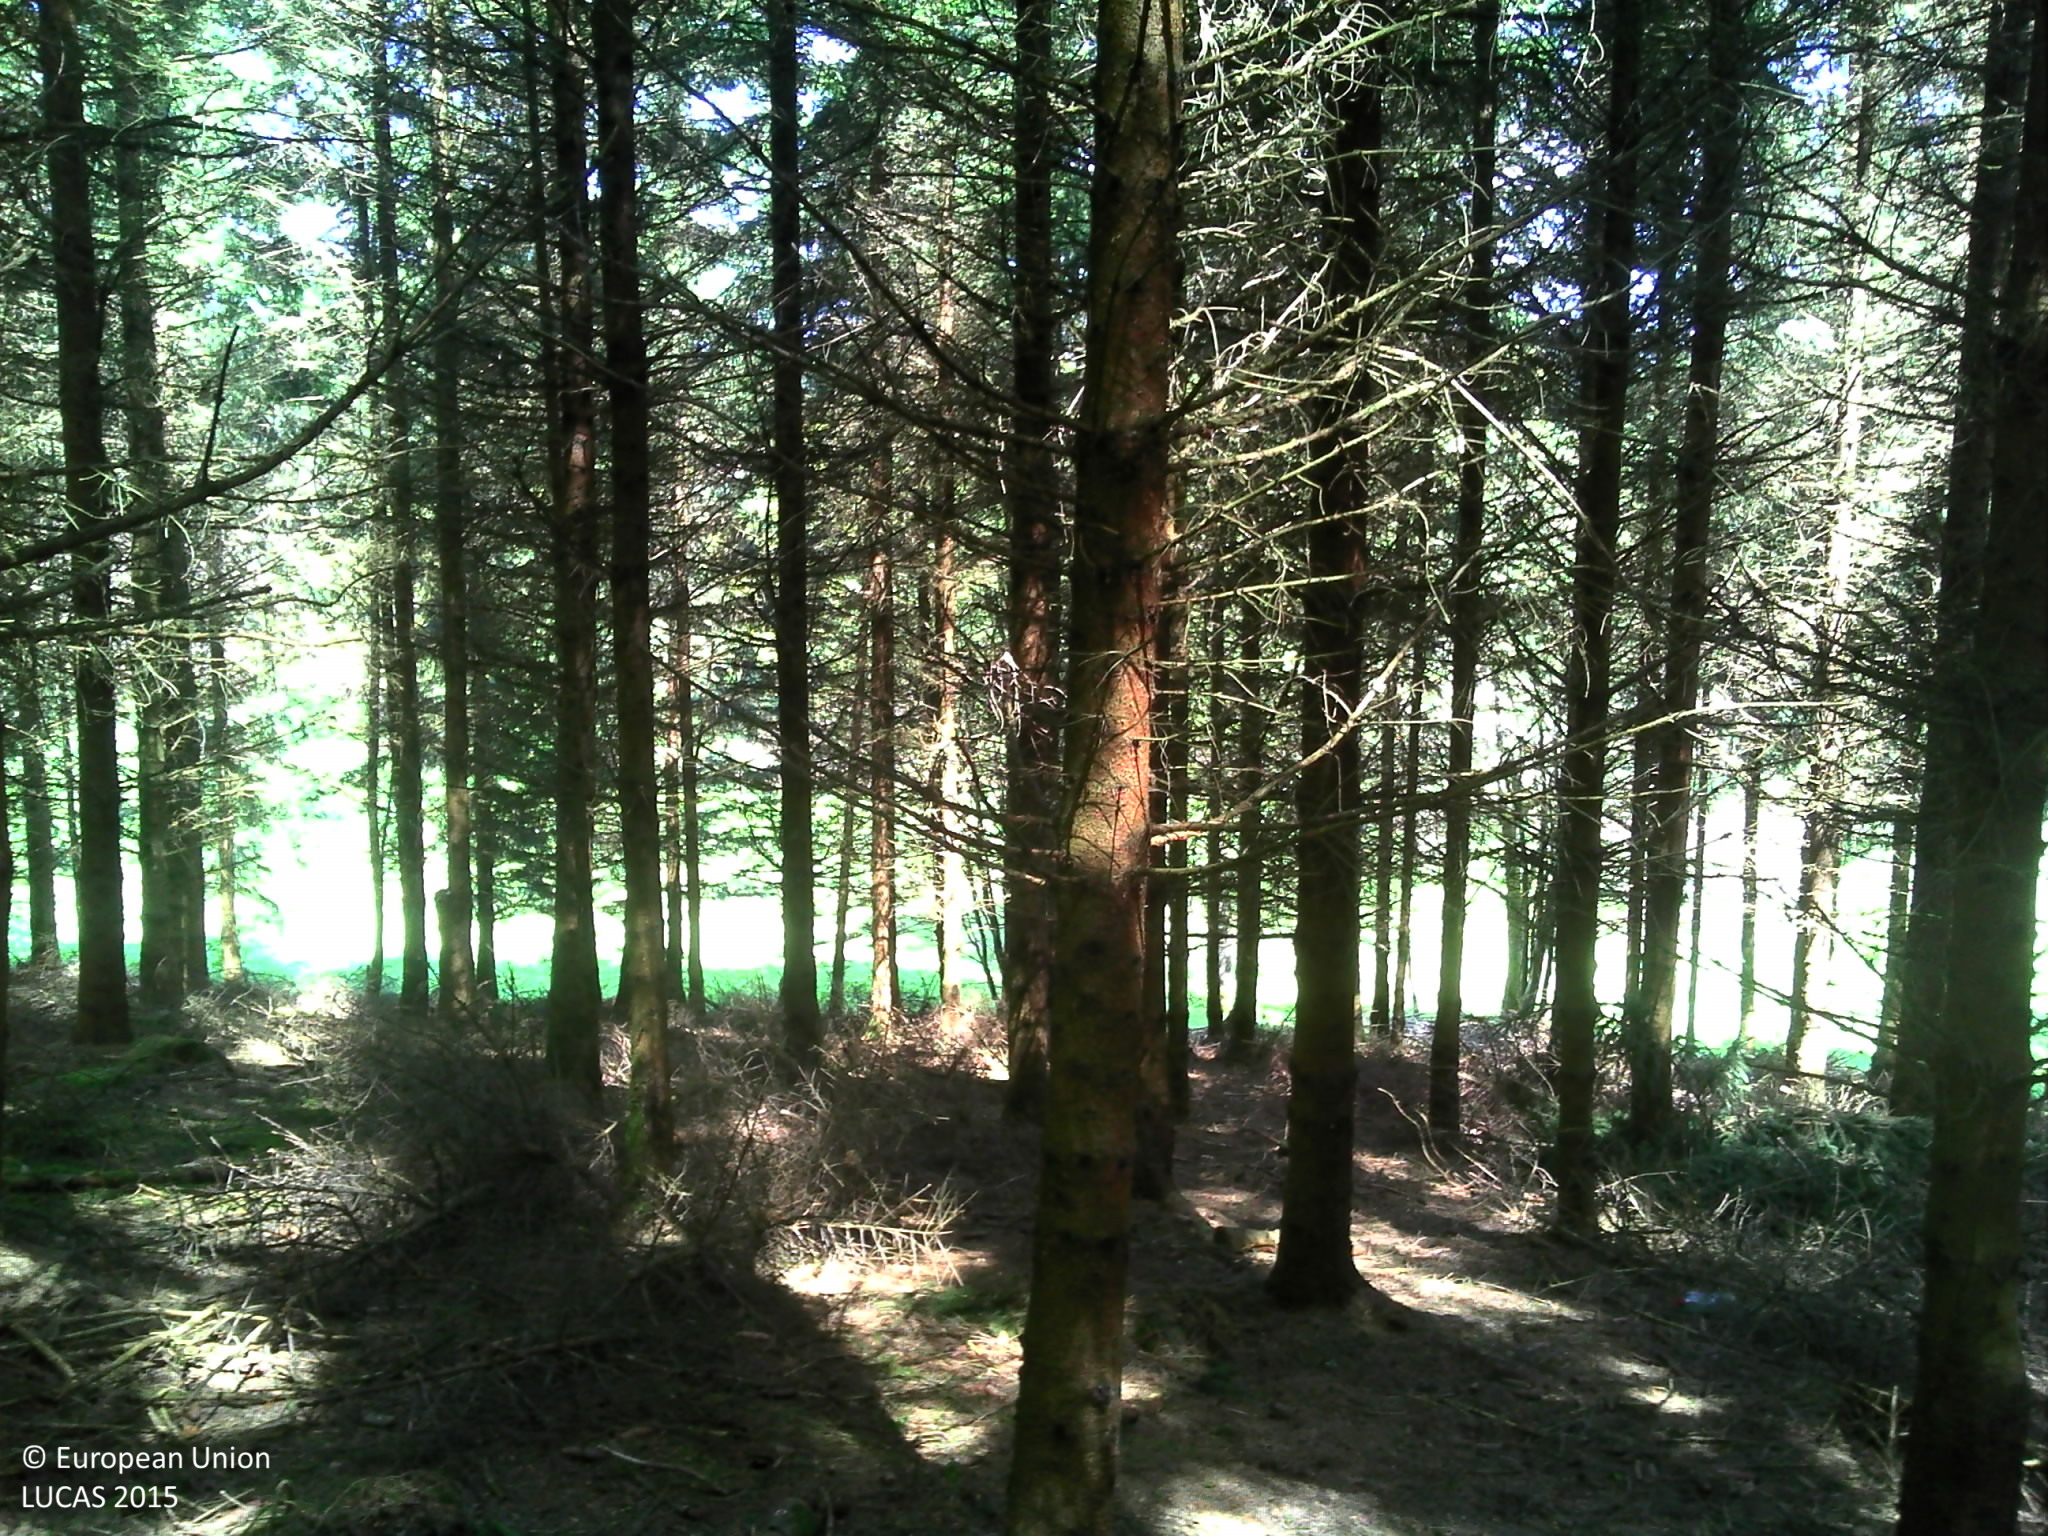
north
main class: Woodland
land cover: Spruce dominated coniferous woodland
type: exotic forest
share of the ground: > 75 %
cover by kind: coniferous forest trees 90 %, broadleaved forest trees 5 %, lichens and mosses 5 %
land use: Forestry
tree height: > 5 m
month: May
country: LU
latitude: 50.1306
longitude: 5.9562
